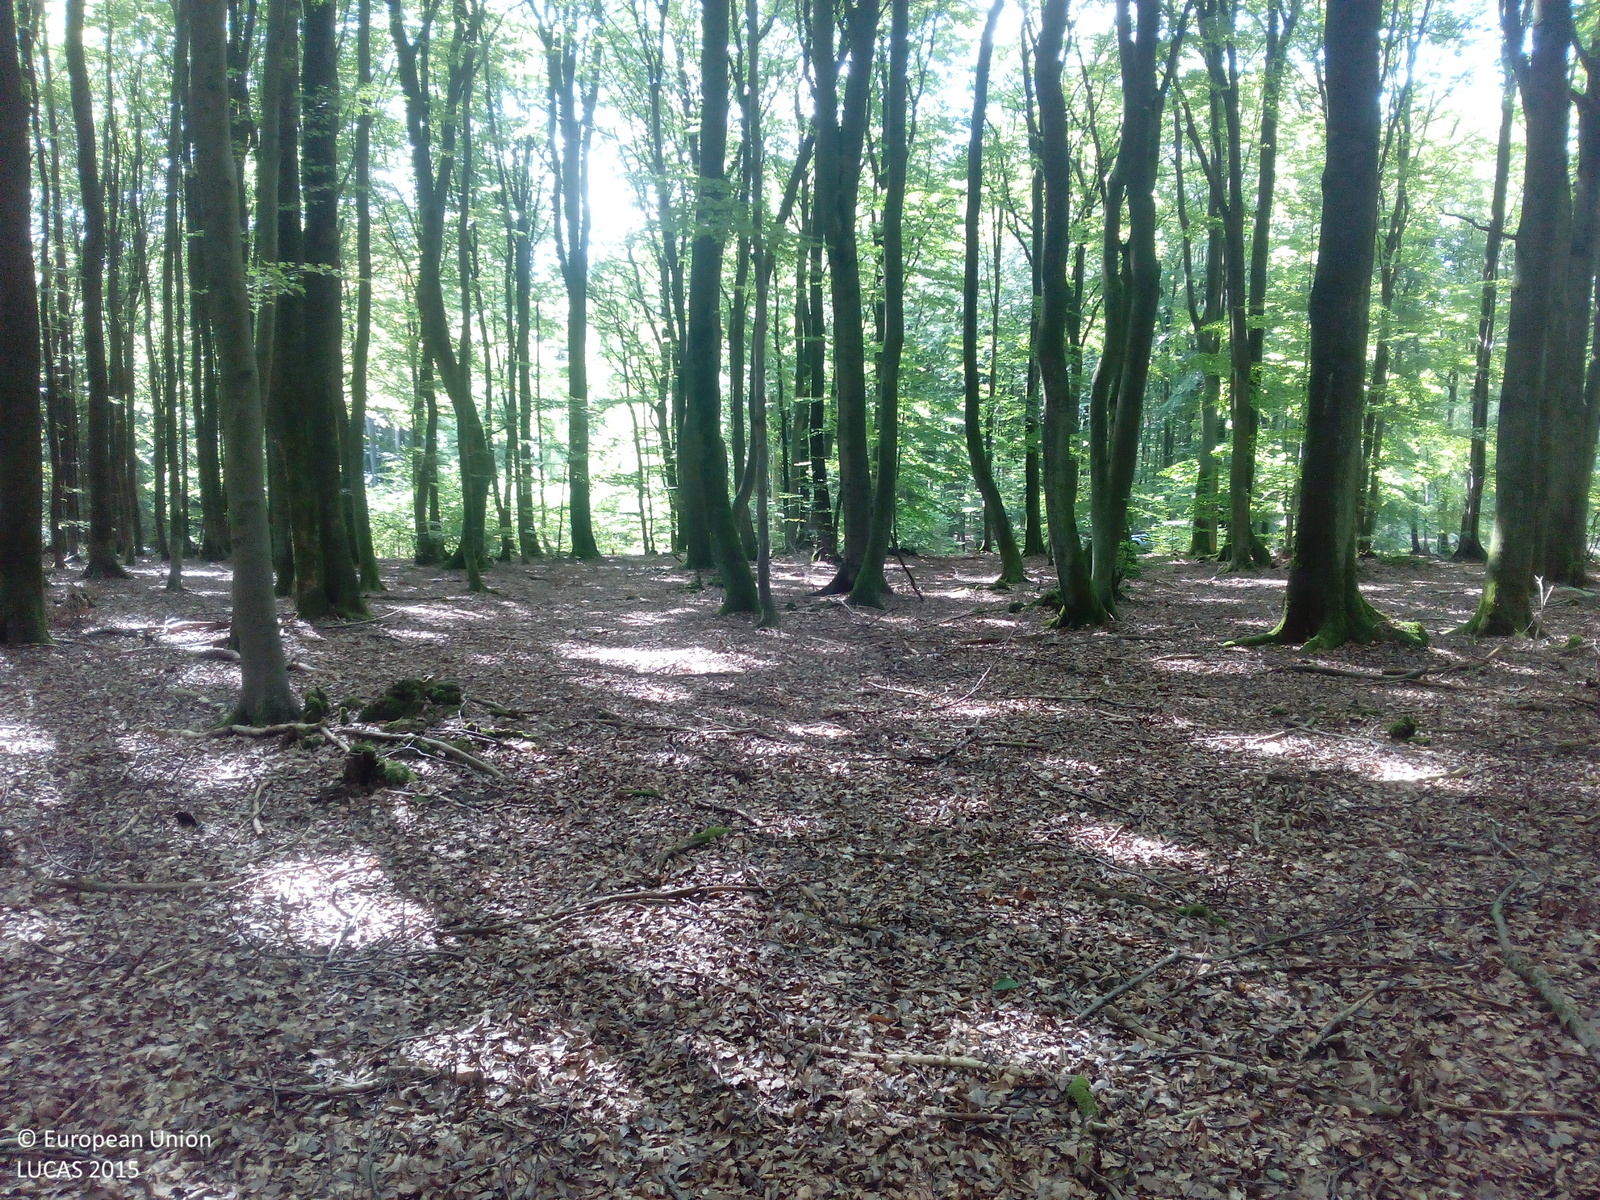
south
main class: Woodland
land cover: Broadleaved woodland
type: beech forest
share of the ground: > 75 %
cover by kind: broadleaved forest trees 90 %, unconsolidated bare surface 10 %
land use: Forestry
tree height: > 5 m
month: September
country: DE
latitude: 49.9496
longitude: 9.5681
